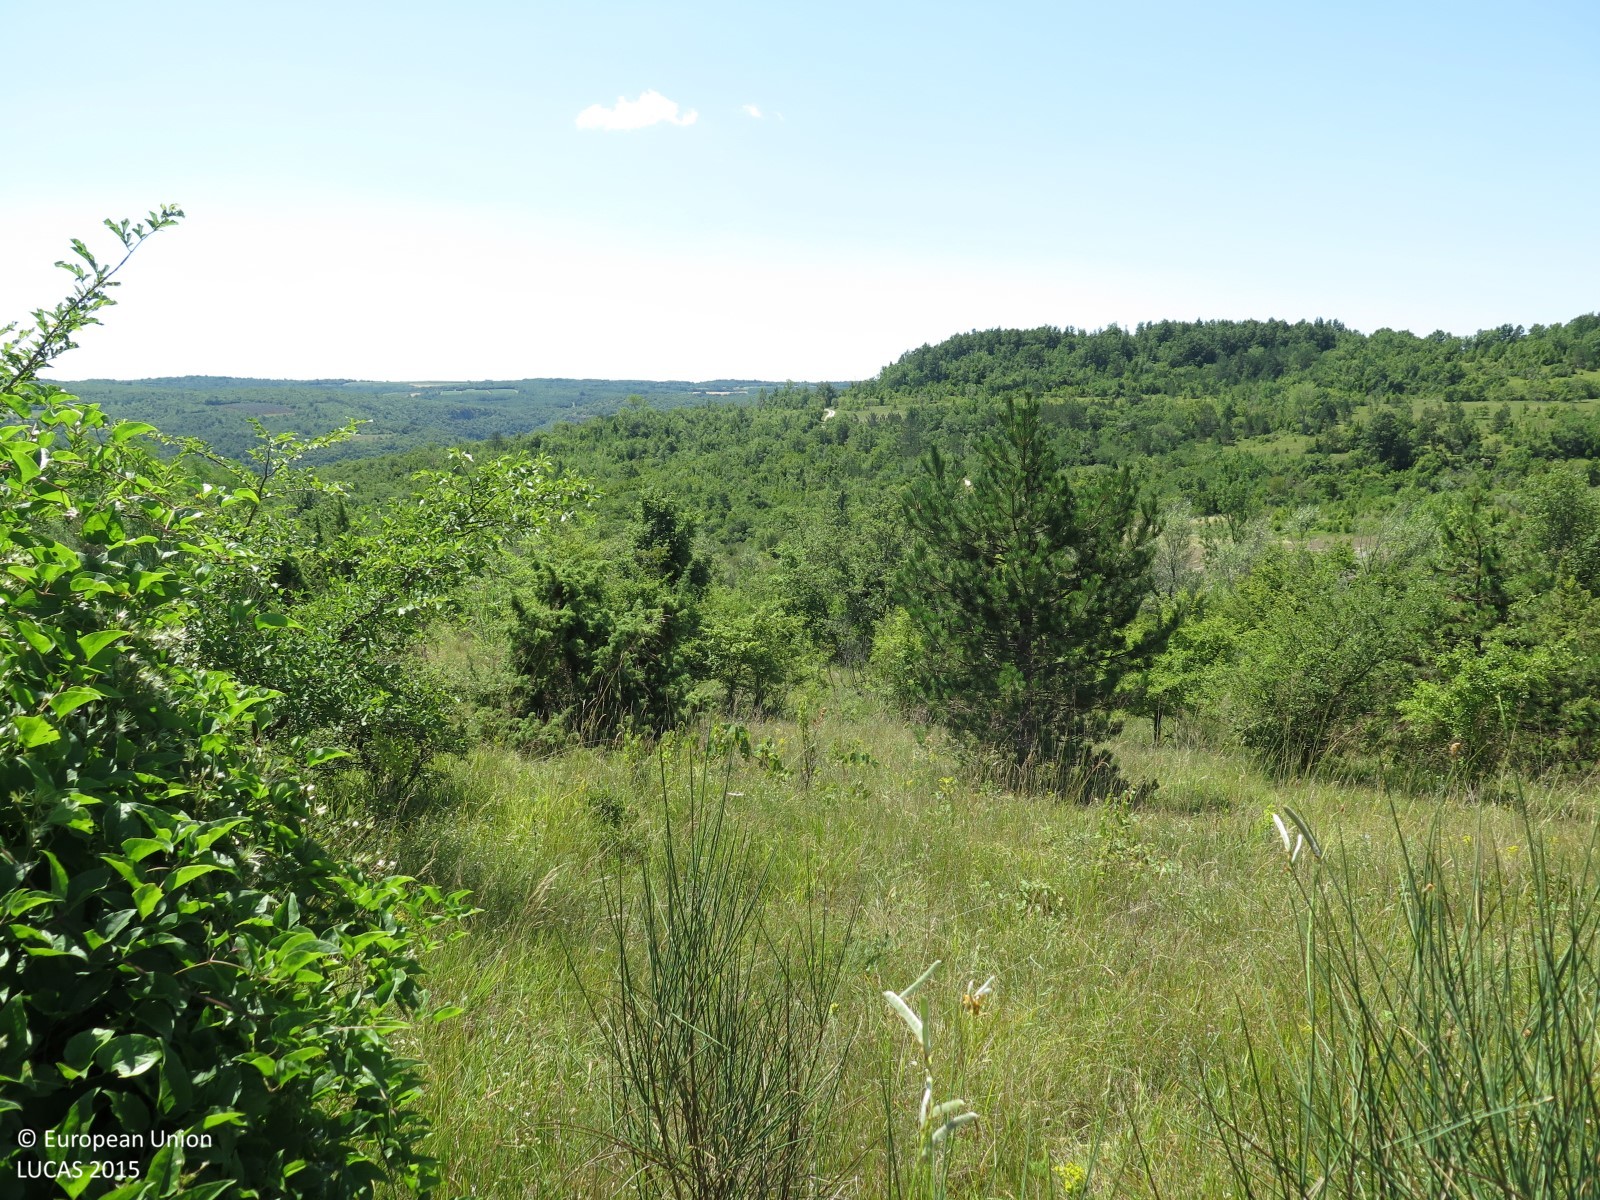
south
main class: Woodland
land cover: Other mixed woodland
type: mesophytic deciduous forest
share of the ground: > 75 %
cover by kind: broadleaved forest trees 65 %, coniferous forest trees 25 %, shrubs 5 %, herbaceous plants 5 %
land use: Semi-natural and natural areas not in use
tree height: < 5 m
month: July
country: HR
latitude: 45.3671
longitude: 13.7105
